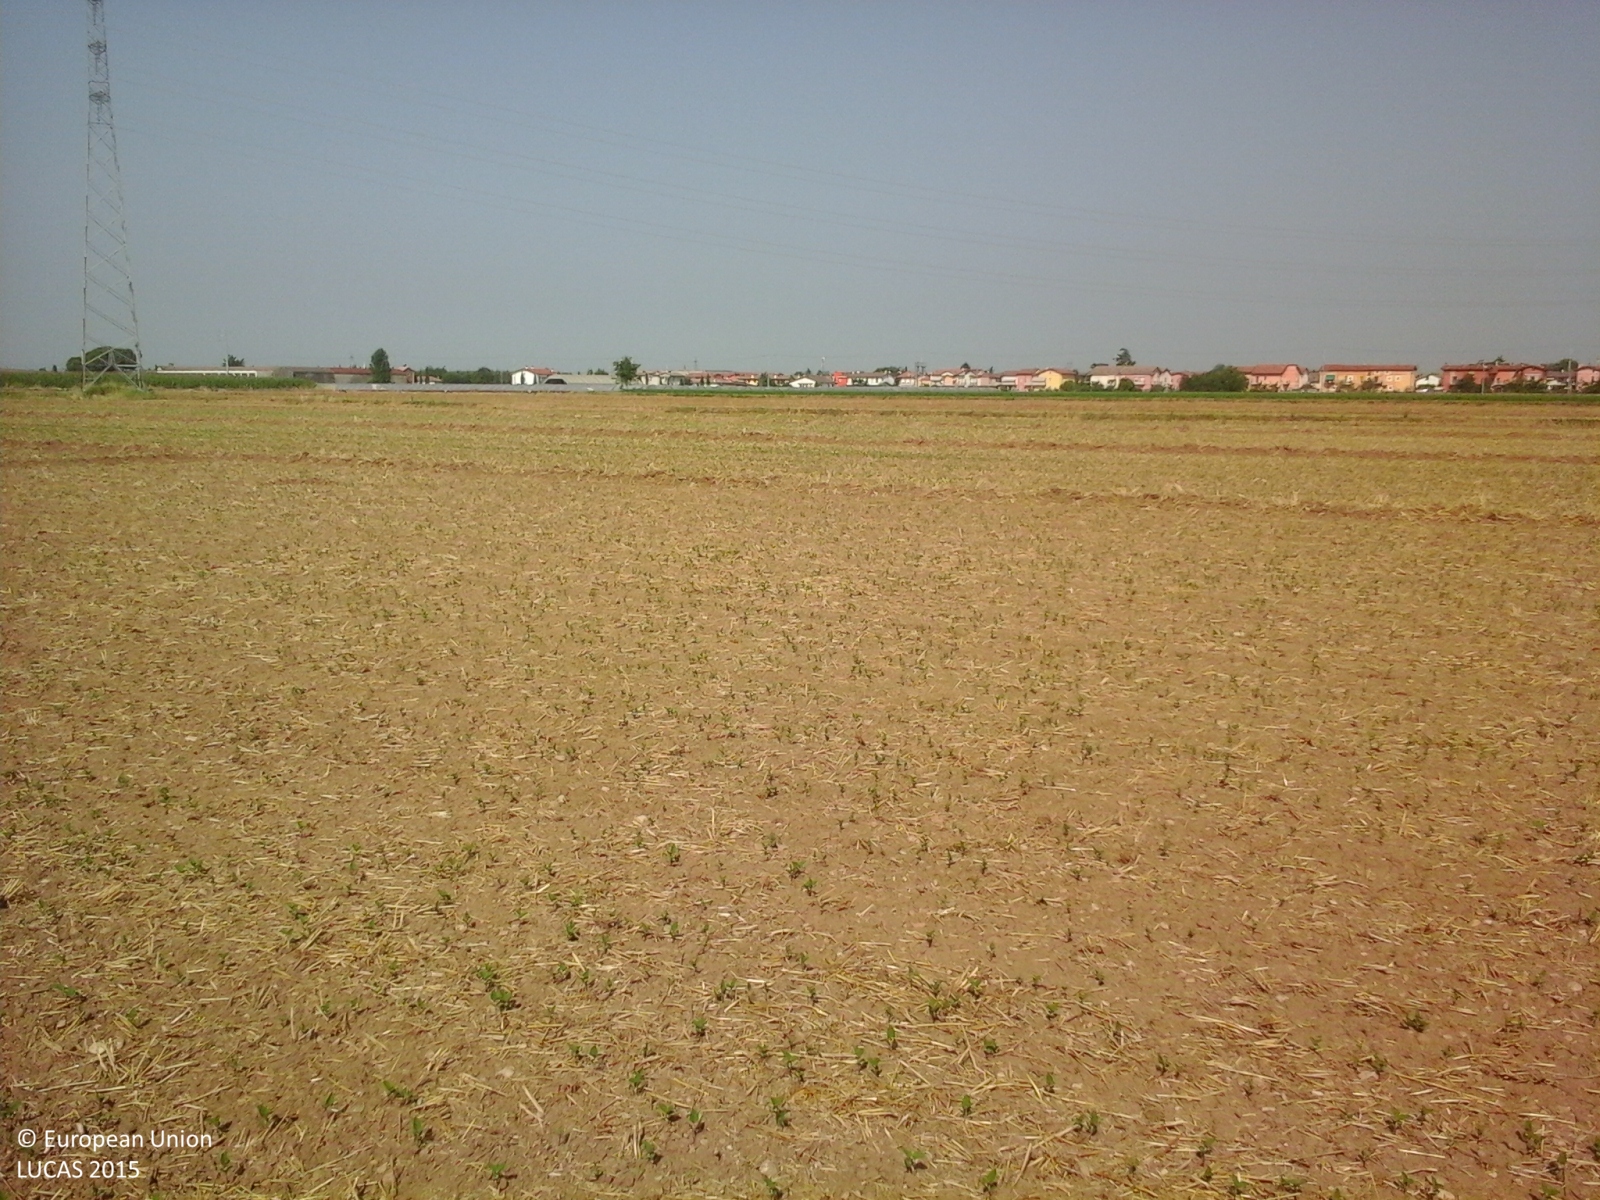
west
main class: Cropland
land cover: Maize
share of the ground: > 75 %
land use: Agriculture (excluding fallow land and kitchen gardens)
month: July
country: IT
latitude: 45.3029
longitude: 10.8275
